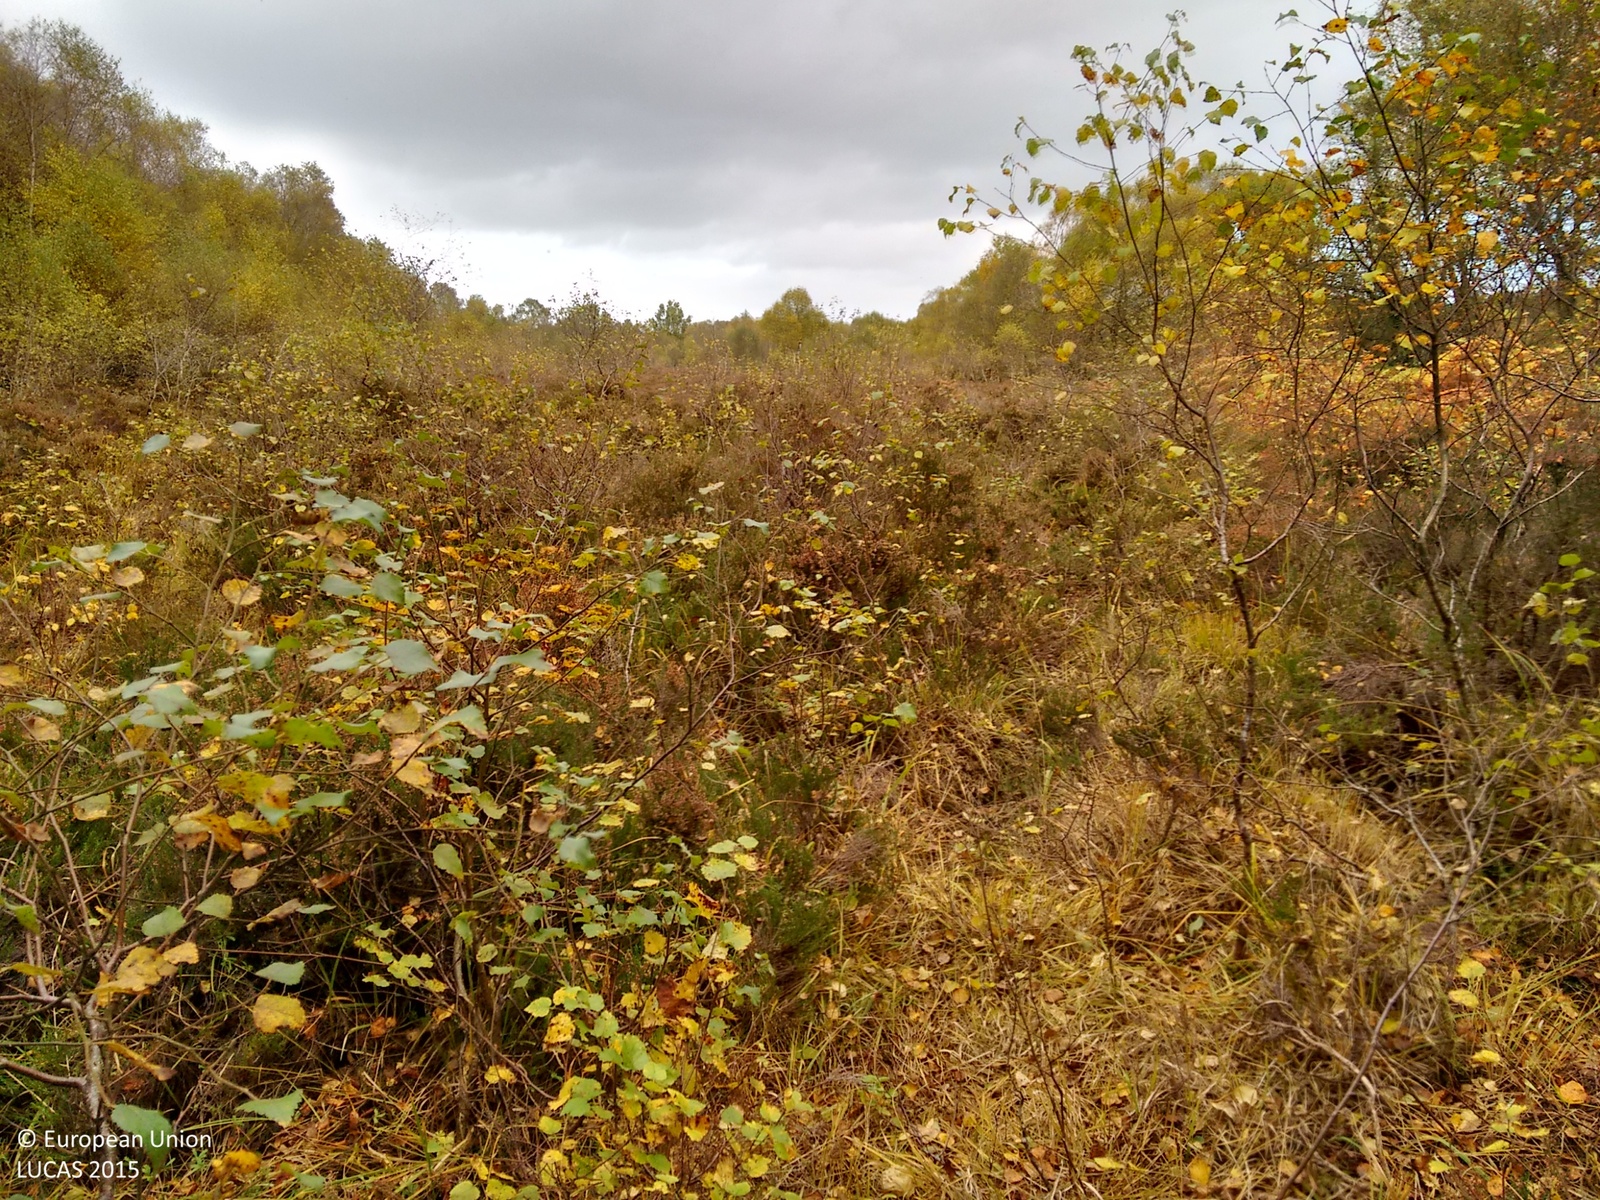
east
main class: Woodland
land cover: Broadleaved woodland
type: acidophilous oak and oak-birch forest
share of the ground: > 75 %
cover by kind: broadleaved forest trees 100 %
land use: Semi-natural and natural areas not in use
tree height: > 5 m
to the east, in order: Broadleaved woodland; Shrubland with sparse tree cover; Lines of trees; Other structural elements; Lines of trees; Shrubland with sparse tree cover; Lines of trees; Shrubland with sparse tree cover; Broadleaved woodland; Shrubland with sparse tree cover; Broadleaved woodland
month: October
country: GB
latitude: 54.3571
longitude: -7.4026
